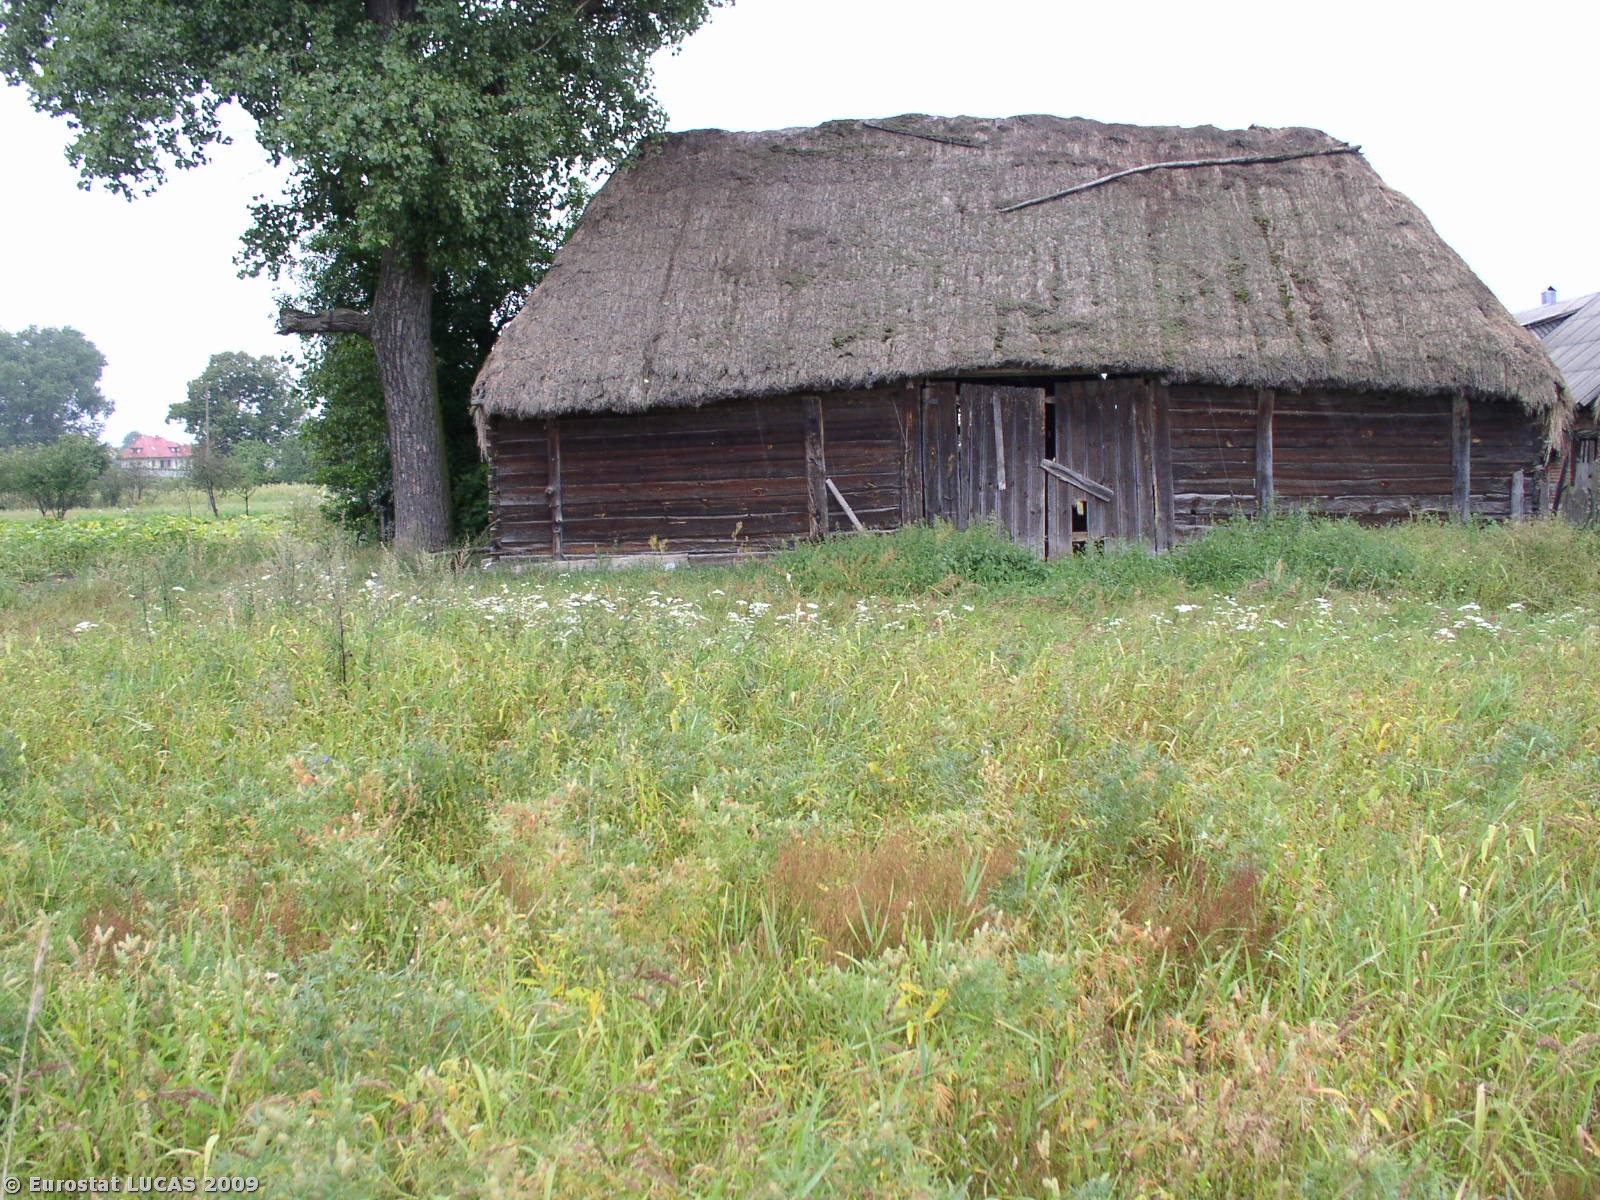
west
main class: Cropland
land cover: Dry pulses
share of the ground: 50 - 75 %
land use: Agriculture (excluding fallow land and kitchen gardens)
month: August
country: PL
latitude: 51.8642
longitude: 21.5679
